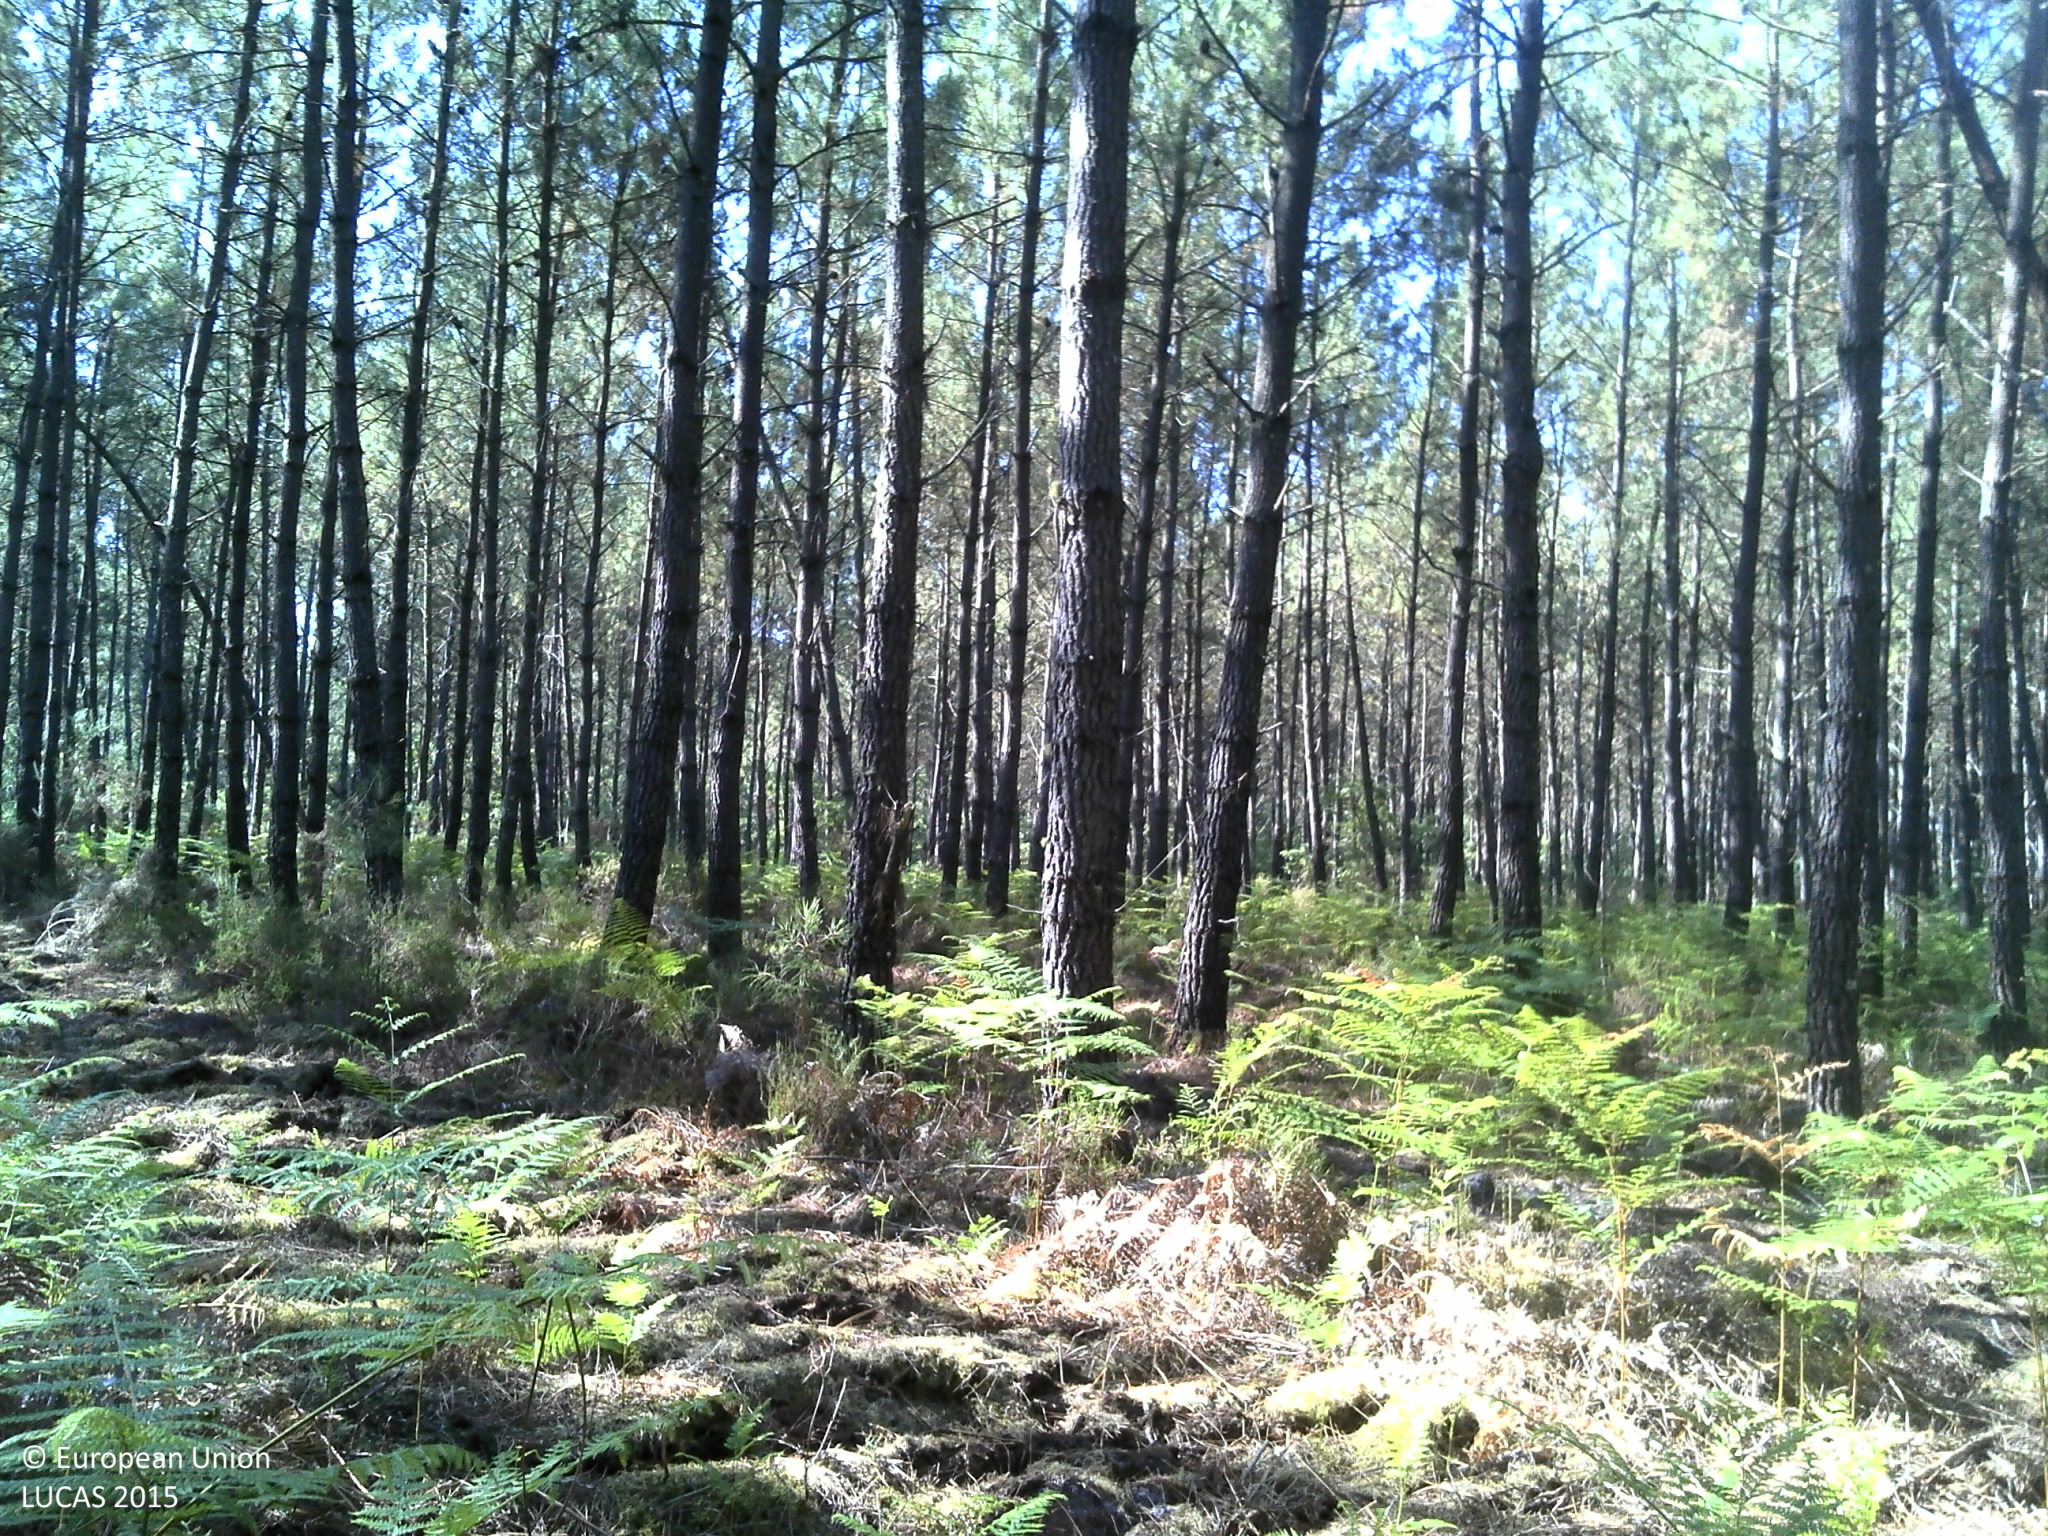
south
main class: Woodland
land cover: Pine dominated coniferous woodland
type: exotic forest
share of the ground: > 75 %
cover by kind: coniferous forest trees 75 %, shrubs 15 %, herbaceous plants 5 %, lichens and mosses 5 %
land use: Forestry
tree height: > 5 m
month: July
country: FR
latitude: 44.4285
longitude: -0.3776
